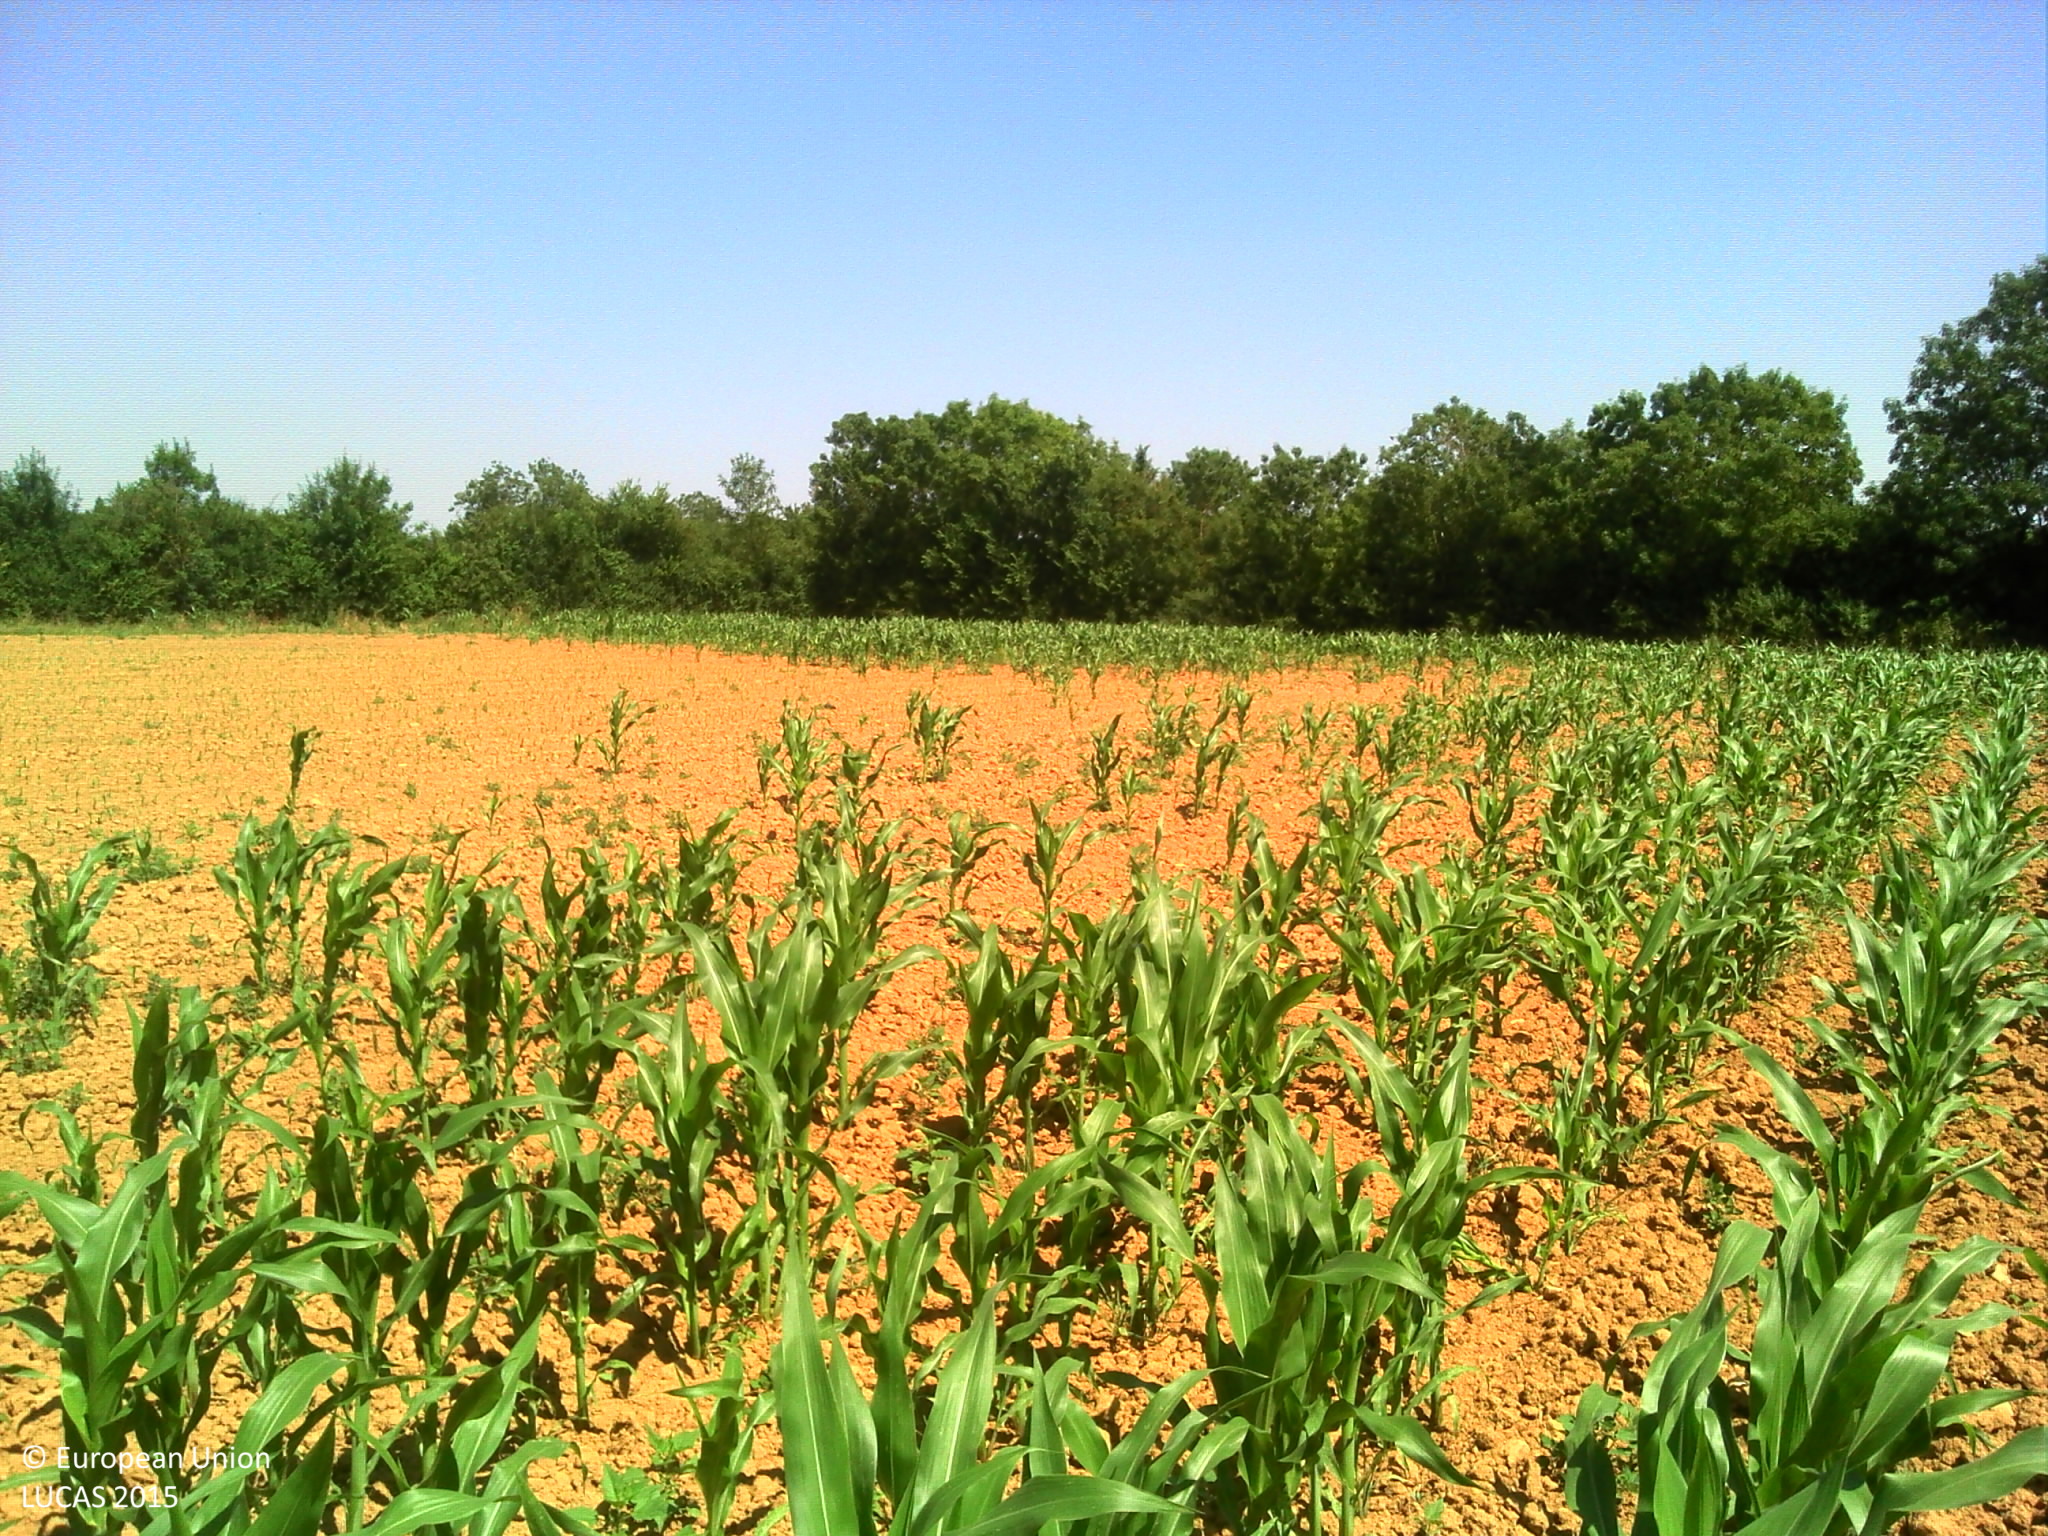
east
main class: Cropland
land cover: Maize
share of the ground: > 75 %
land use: Agriculture (excluding fallow land and kitchen gardens)
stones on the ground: < 10 %
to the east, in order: Maize; Tracks; Abandoned hedges; Common wheat; Abandoned hedges; Grass margins; Tracks; Grass margins; Abandoned hedges; Fences; Grassland without tree/shrub cover; Fences; Broadleaved woodland; Grassland with sparse tree/shrub cover; Grassland without tree/shrub cover; Ditches and canals; Abandoned hedges; Grassland without tree/shrub cover
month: July
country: FR
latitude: 46.4718
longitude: -1.3533
